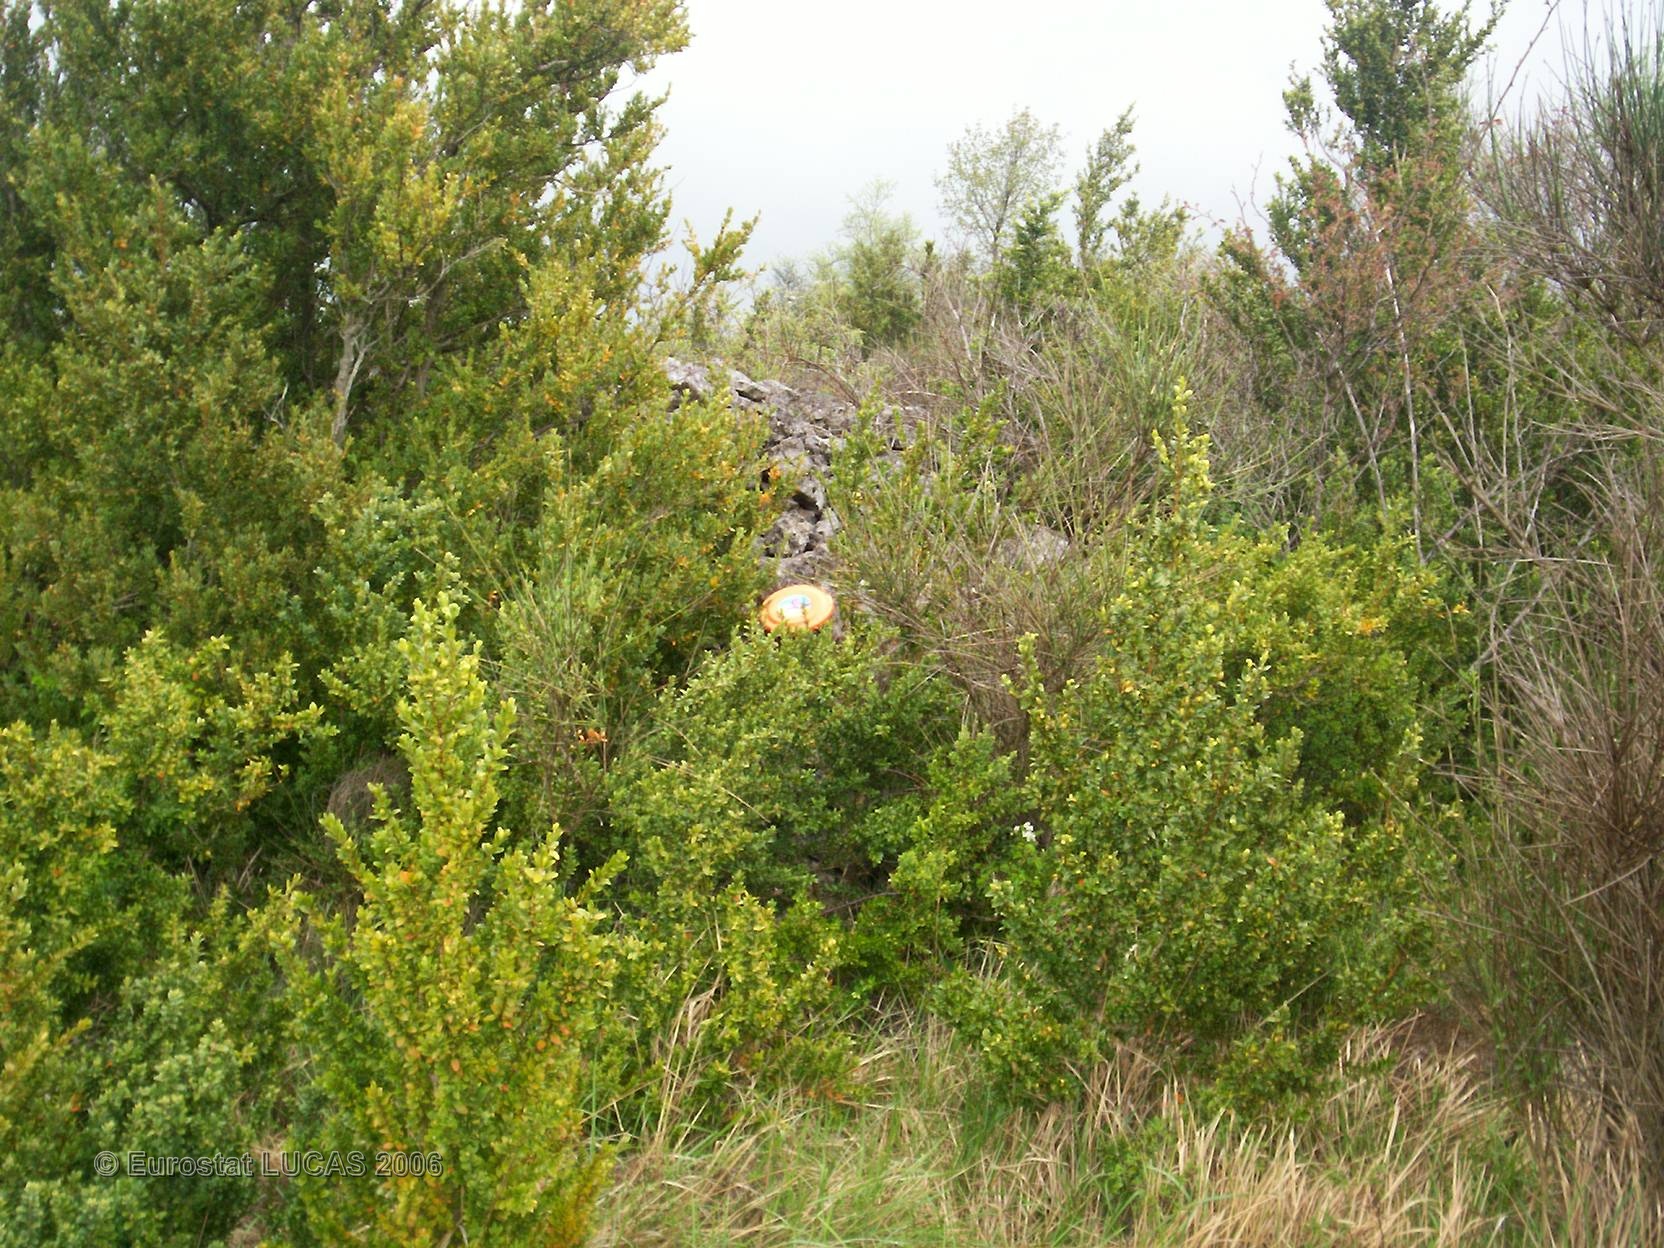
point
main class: Shrubland
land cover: Shrubland without tree cover
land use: Unused
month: May
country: FR
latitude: 43.9291
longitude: 3.4929
